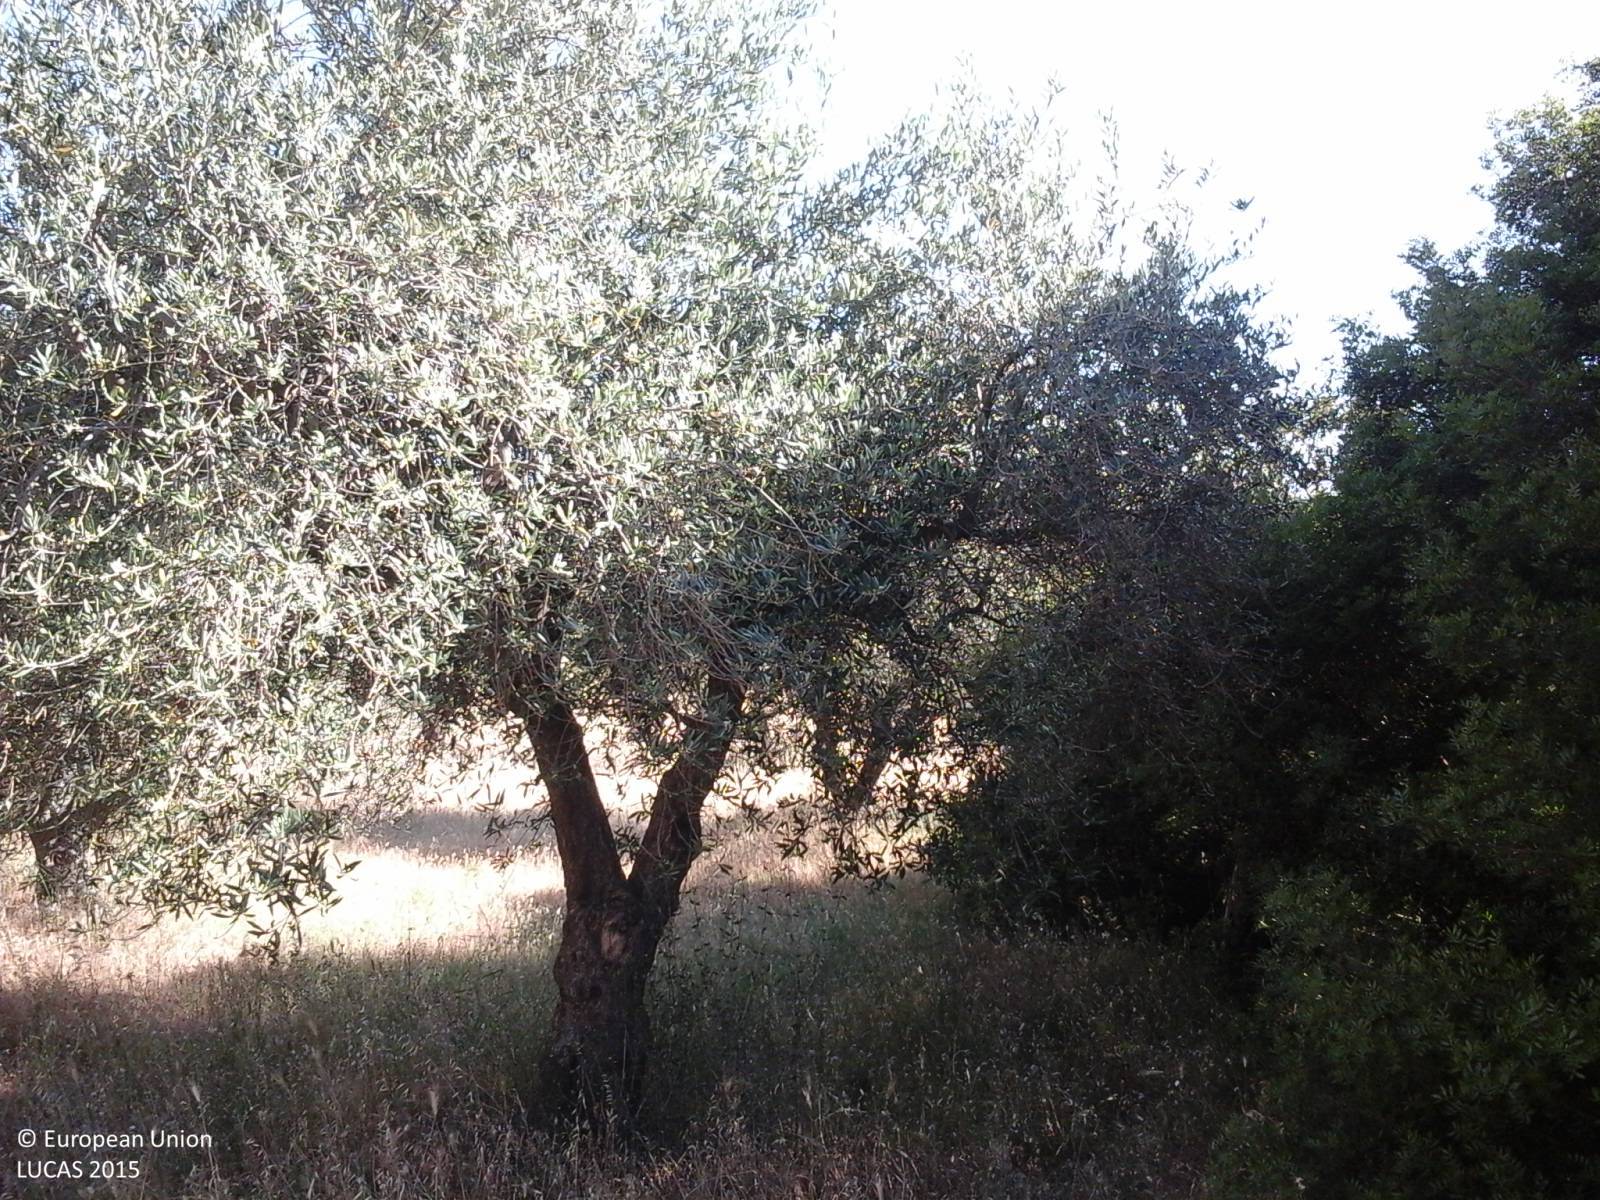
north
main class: Cropland
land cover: Olive groves
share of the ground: > 75 %
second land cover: Grassland without tree/shrub cover
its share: > 75 %
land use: Agriculture (excluding fallow land and kitchen gardens)
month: May
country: IT
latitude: 40.2840
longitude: 9.4735
